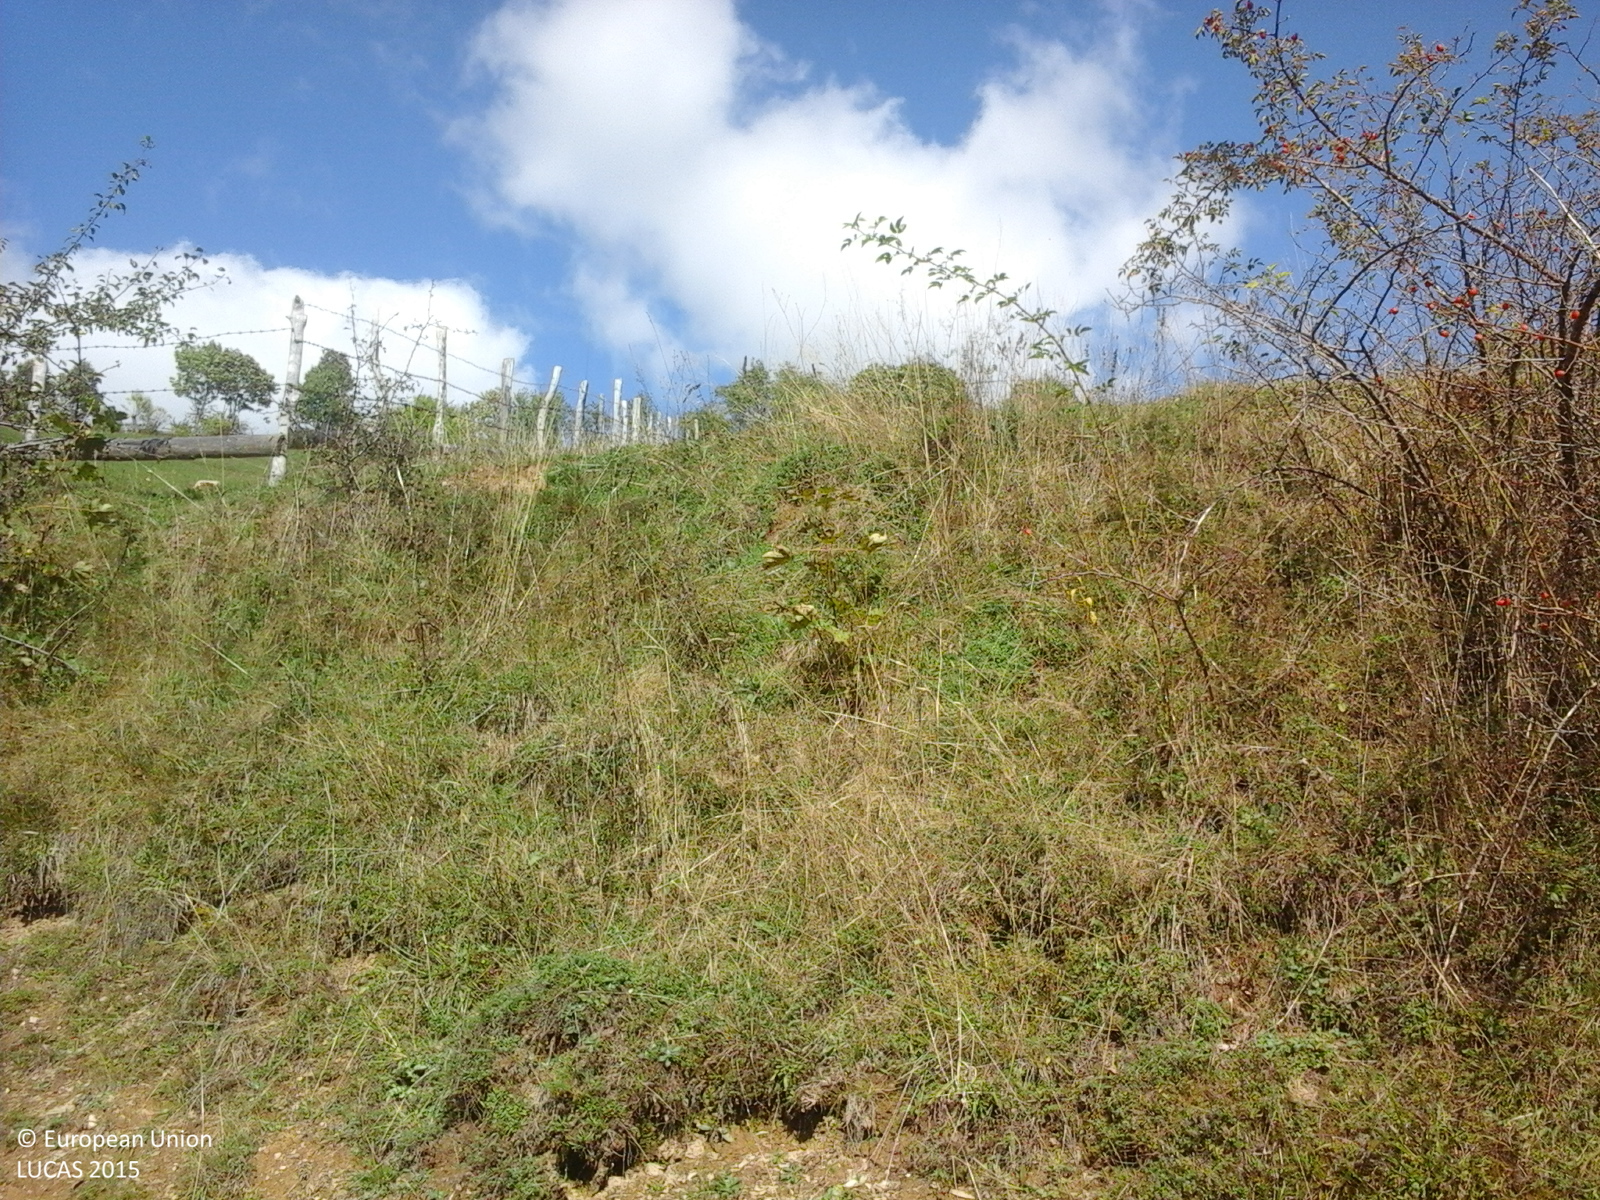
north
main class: Grassland
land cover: Grassland without tree/shrub cover
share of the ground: > 75 %
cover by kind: herbaceous plants 100 %
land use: Agriculture (excluding fallow land and kitchen gardens)
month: October
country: RO
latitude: 46.4230
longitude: 22.8999
